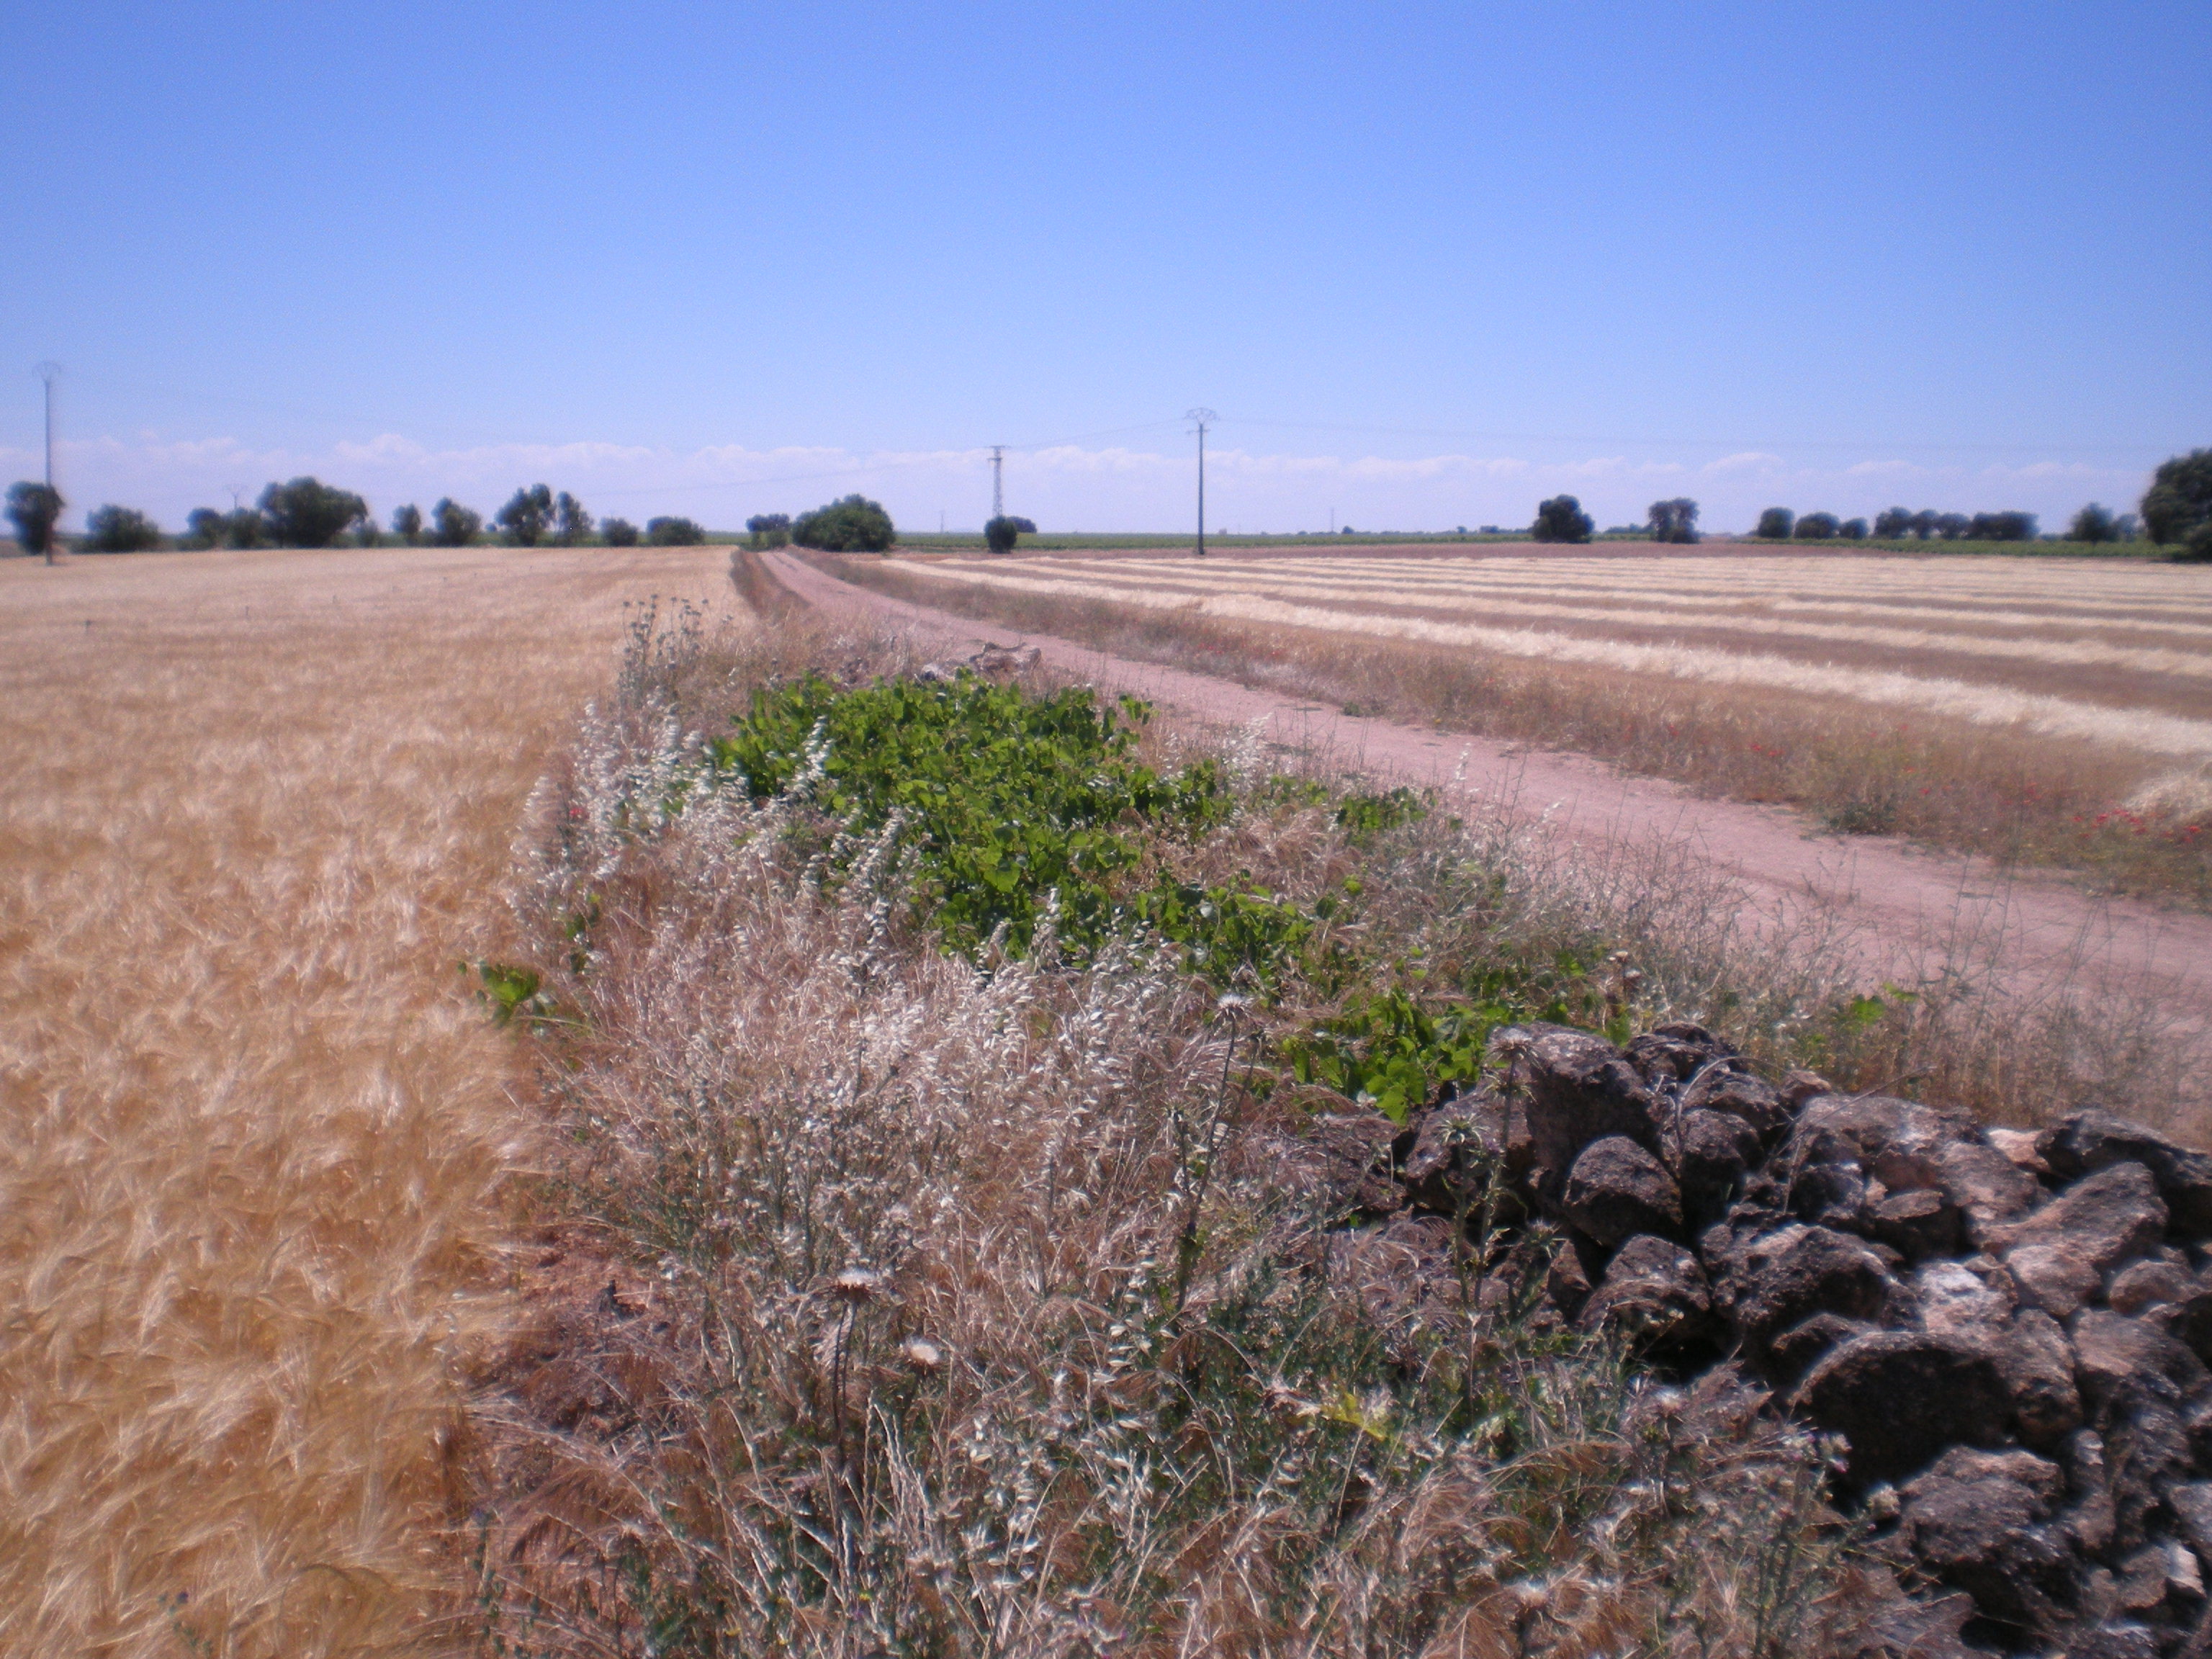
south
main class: Cropland
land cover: Barley
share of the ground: > 75 %
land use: Agriculture (excluding fallow land and kitchen gardens)
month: May
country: ES
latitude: 39.2065
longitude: -3.4630
